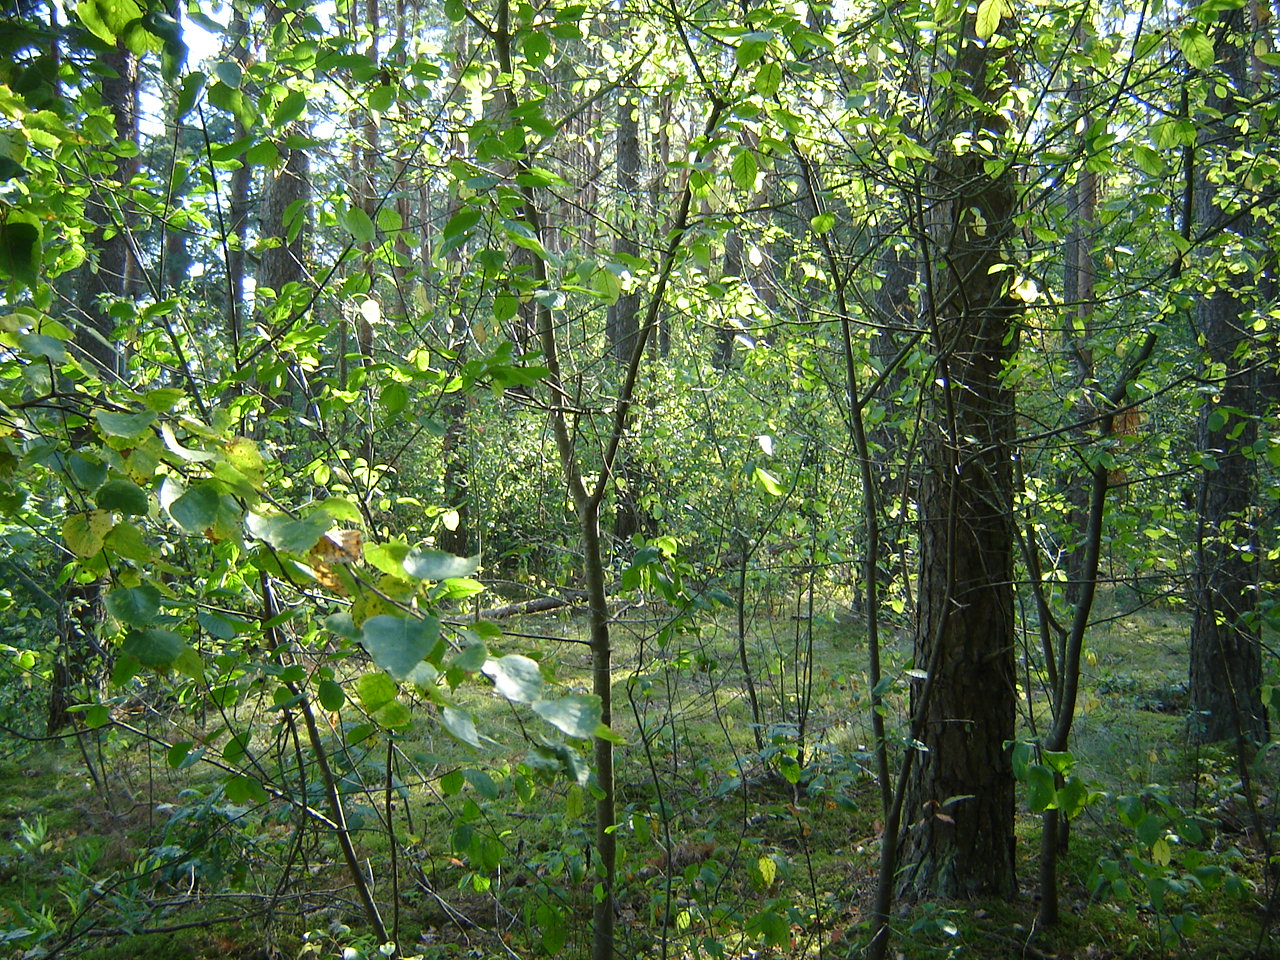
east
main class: Woodland
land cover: Pine dominated coniferous woodland
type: hemiboreal forest and nemoral coniferous forest and mixed broadleaved-coniferous forest
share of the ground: > 75 %
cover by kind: coniferous forest trees 80 %, broadleaved forest trees 5 %, shrubs 5 %, herbaceous plants 5 %, lichens and mosses 5 %
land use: Forestry
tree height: > 5 m
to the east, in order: Pine dominated coniferous woodland; Grassland without tree/shrub cover; Electric lines; Grassland without tree/shrub cover
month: August
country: LT
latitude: 54.8785
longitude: 24.8386
